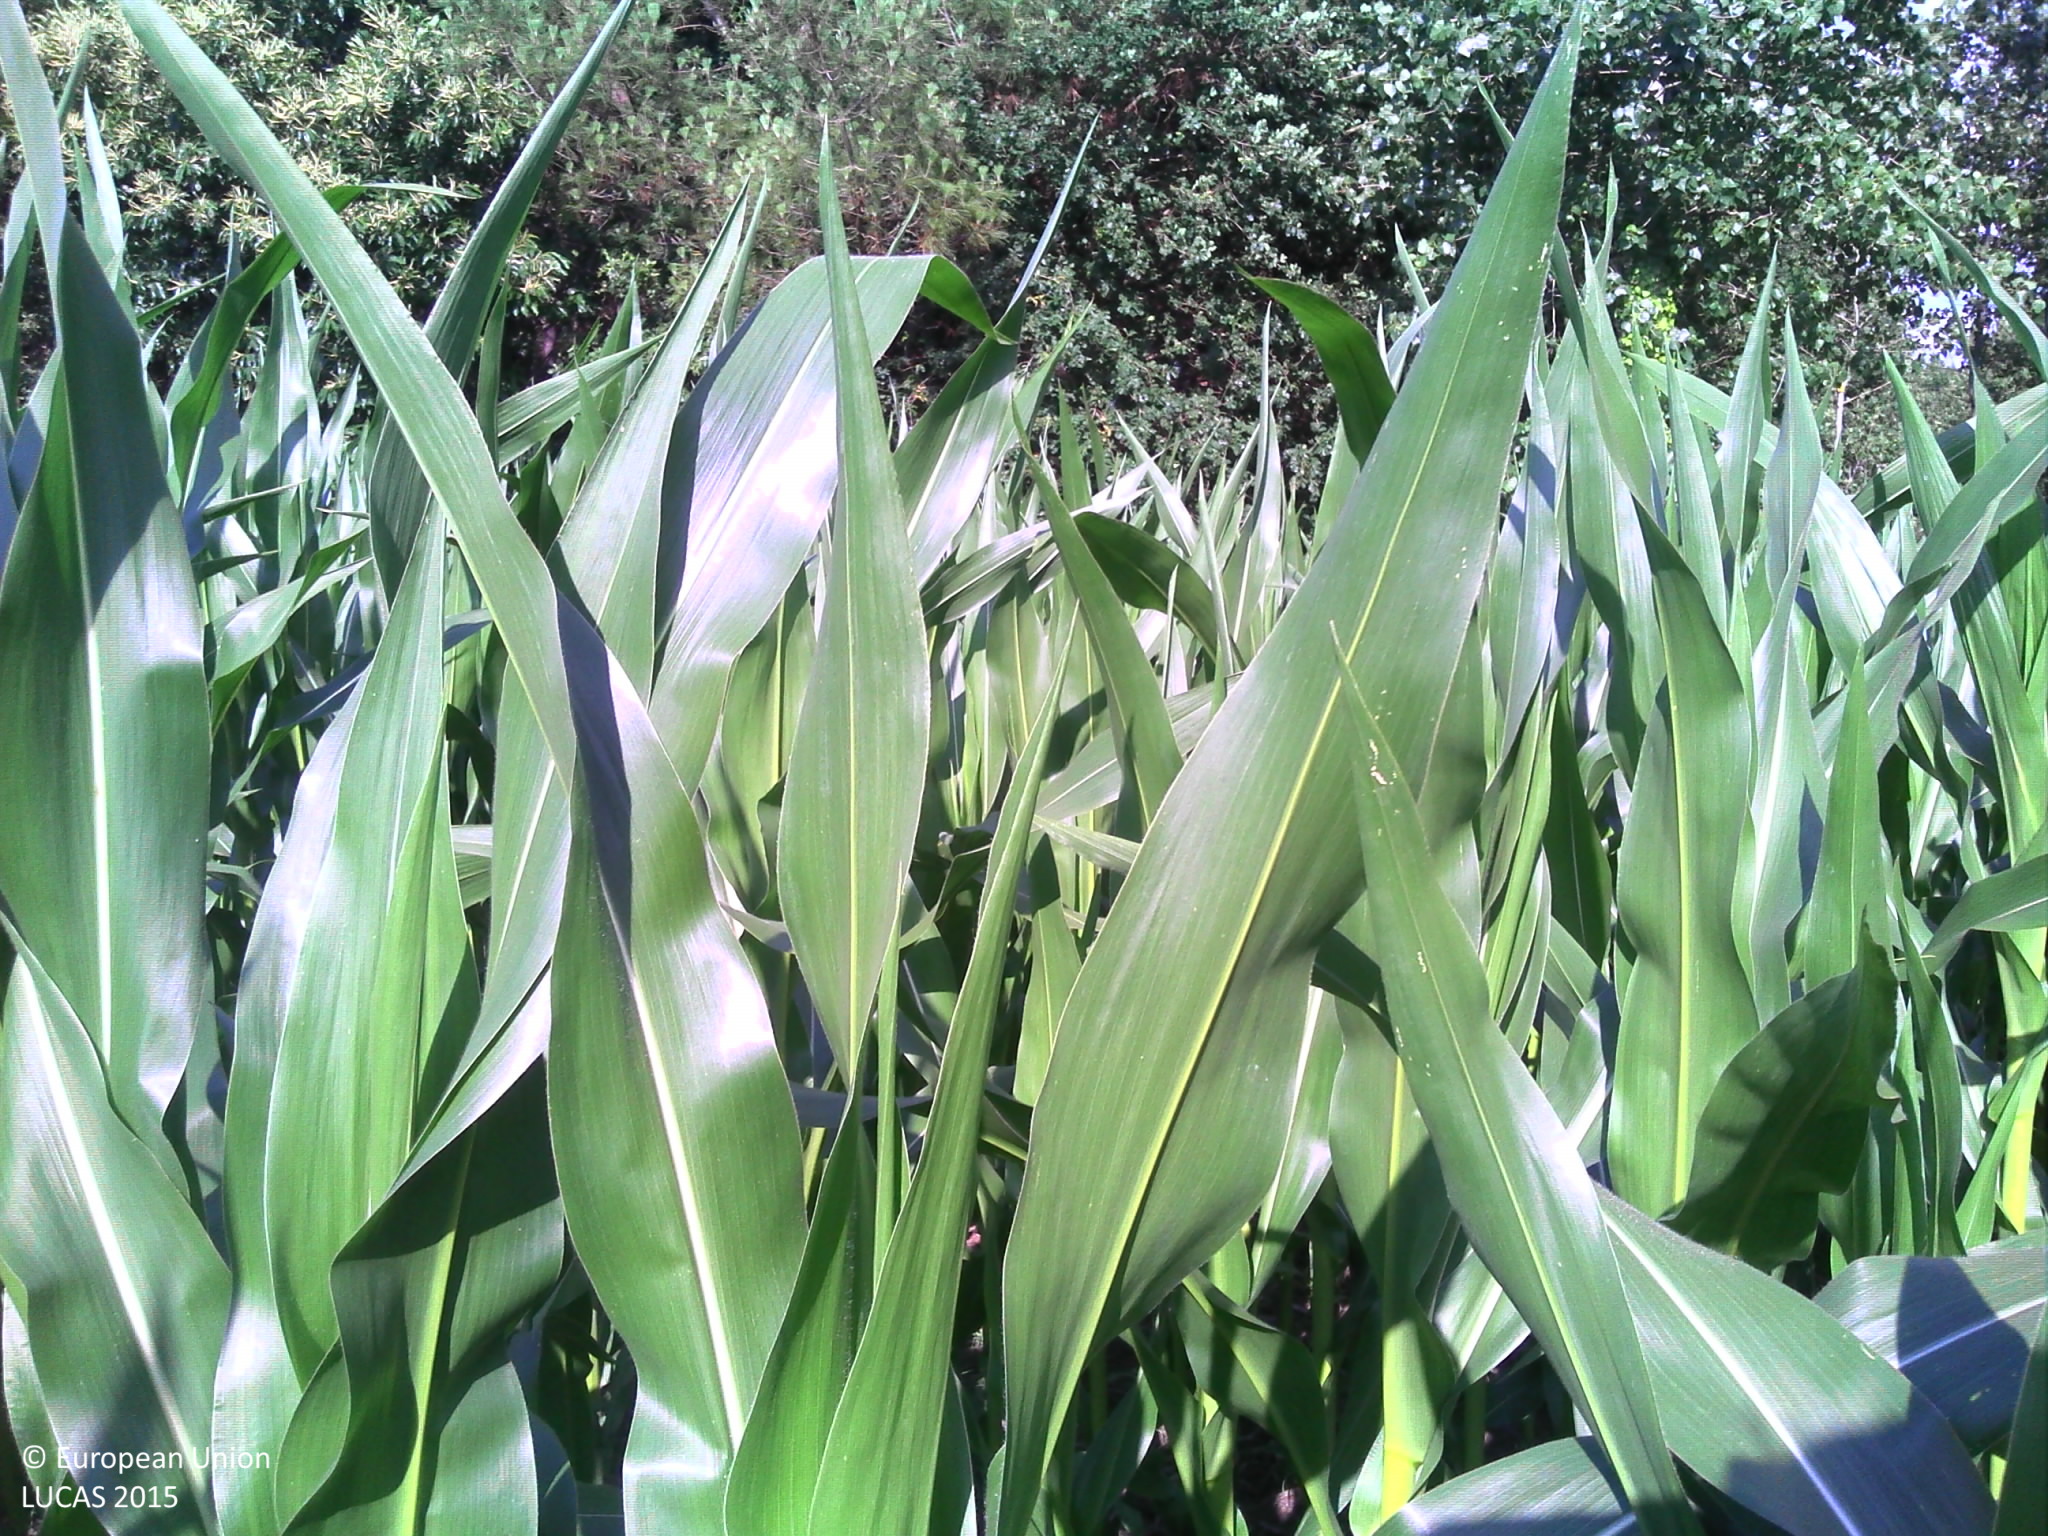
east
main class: Cropland
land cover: Maize
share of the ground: > 75 %
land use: Agriculture (excluding fallow land and kitchen gardens)
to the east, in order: Maize; Broadleaved woodland; Pine dominated coniferous woodland; Tracks; Pine dominated coniferous woodland; Ditches and canals; Grass margins; Paved roads, cycling and walking lanes; Grass margins; Ditches and canals; Maize
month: June
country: FR
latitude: 43.8654
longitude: -0.3755
